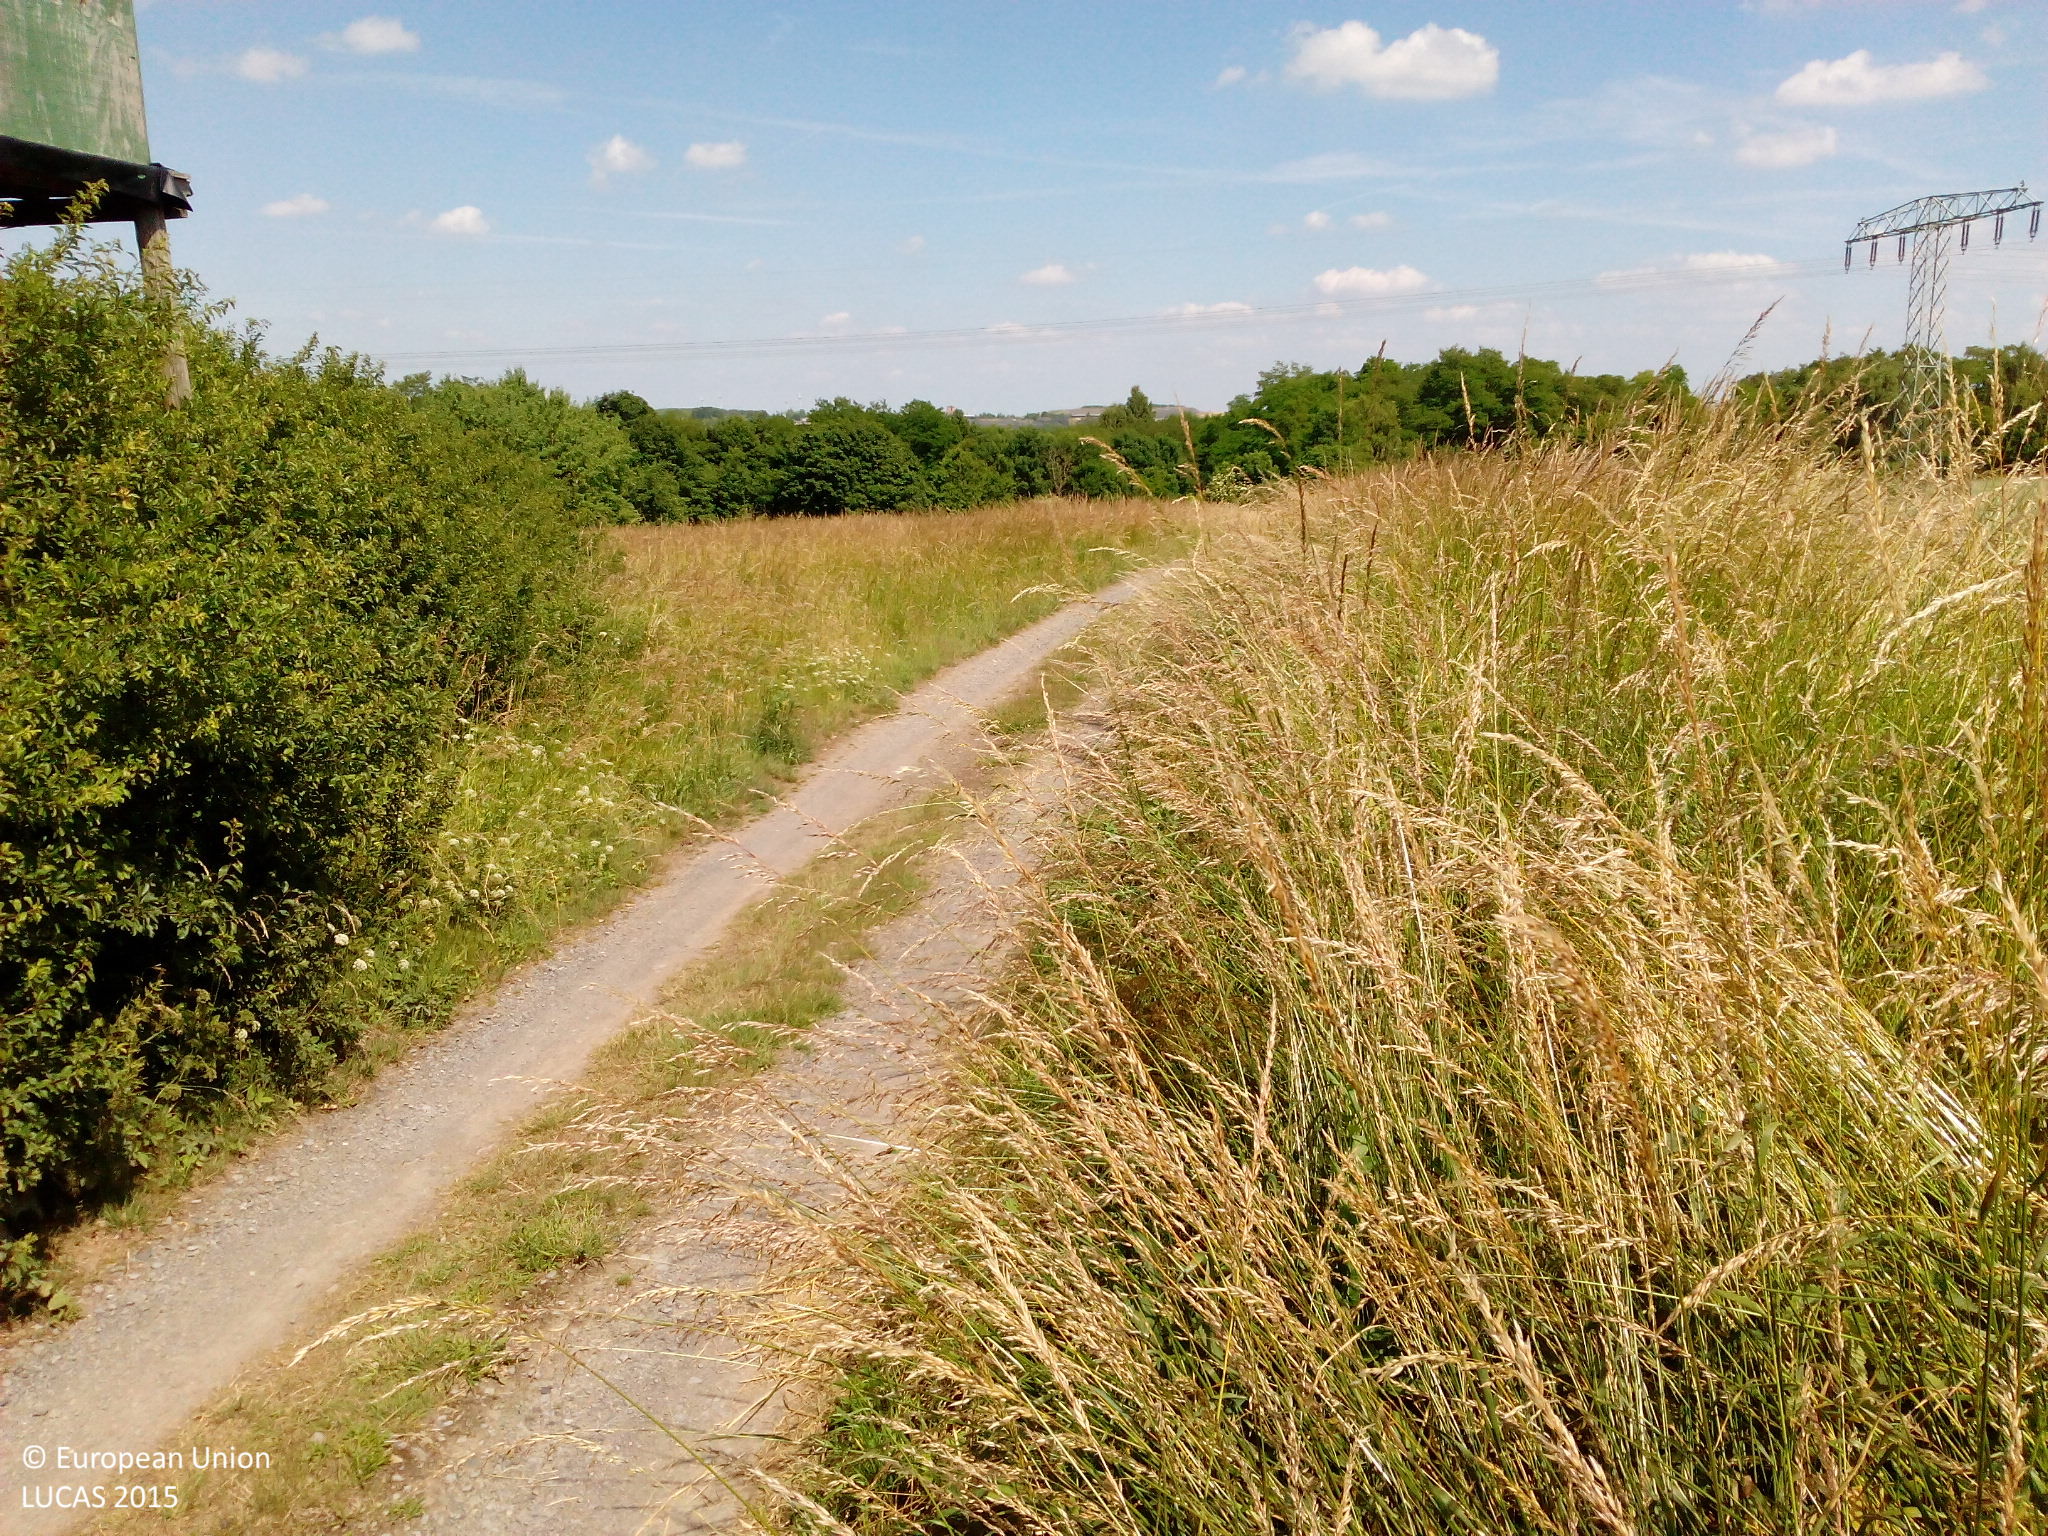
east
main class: Grassland
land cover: Grassland without tree/shrub cover
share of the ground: > 75 %
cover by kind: herbaceous plants 100 %
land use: Road transport
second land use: Agriculture (excluding fallow land and kitchen gardens)
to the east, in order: Grassland without tree/shrub cover; Tracks; Grassland without tree/shrub cover; Electric lines; Grassland without tree/shrub cover; Broadleaved woodland; Grass margins; Railways; Grass margins; Broadleaved woodland
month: June
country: DE
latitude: 51.5416
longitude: 11.4559
